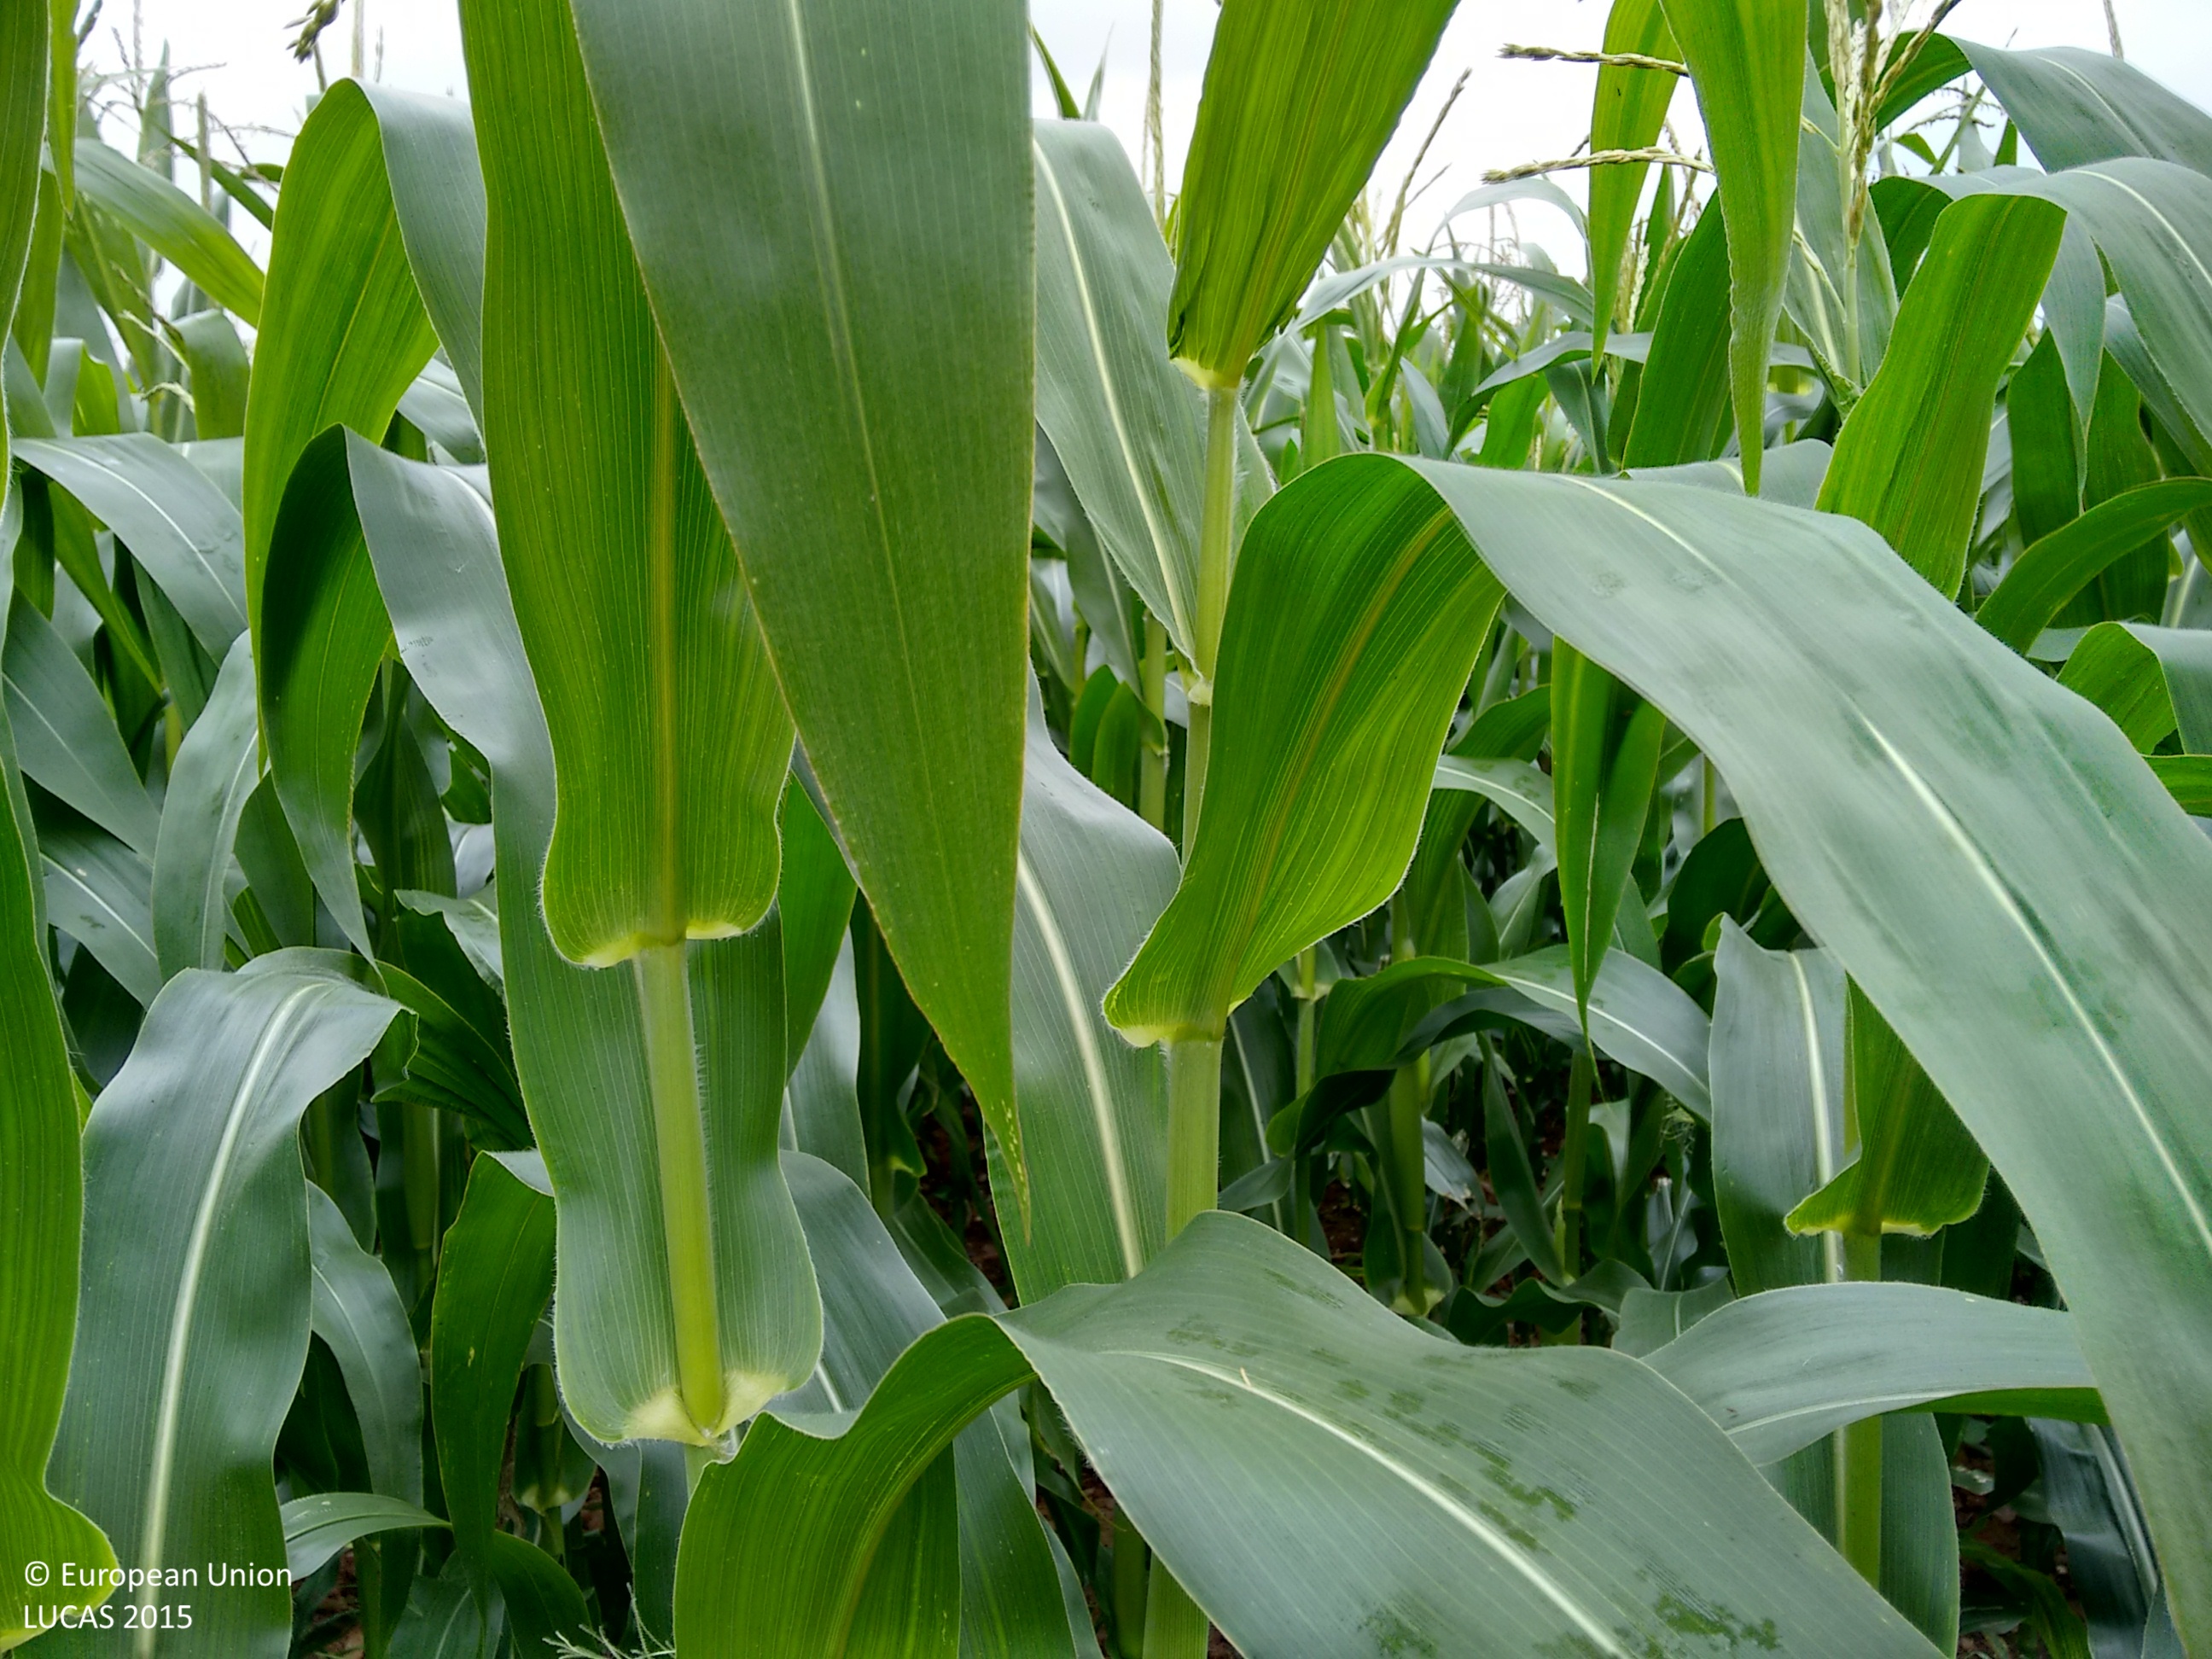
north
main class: Cropland
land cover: Maize
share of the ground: > 75 %
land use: Agriculture (excluding fallow land and kitchen gardens)
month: August
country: GB
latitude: 52.6655
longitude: -1.3605
